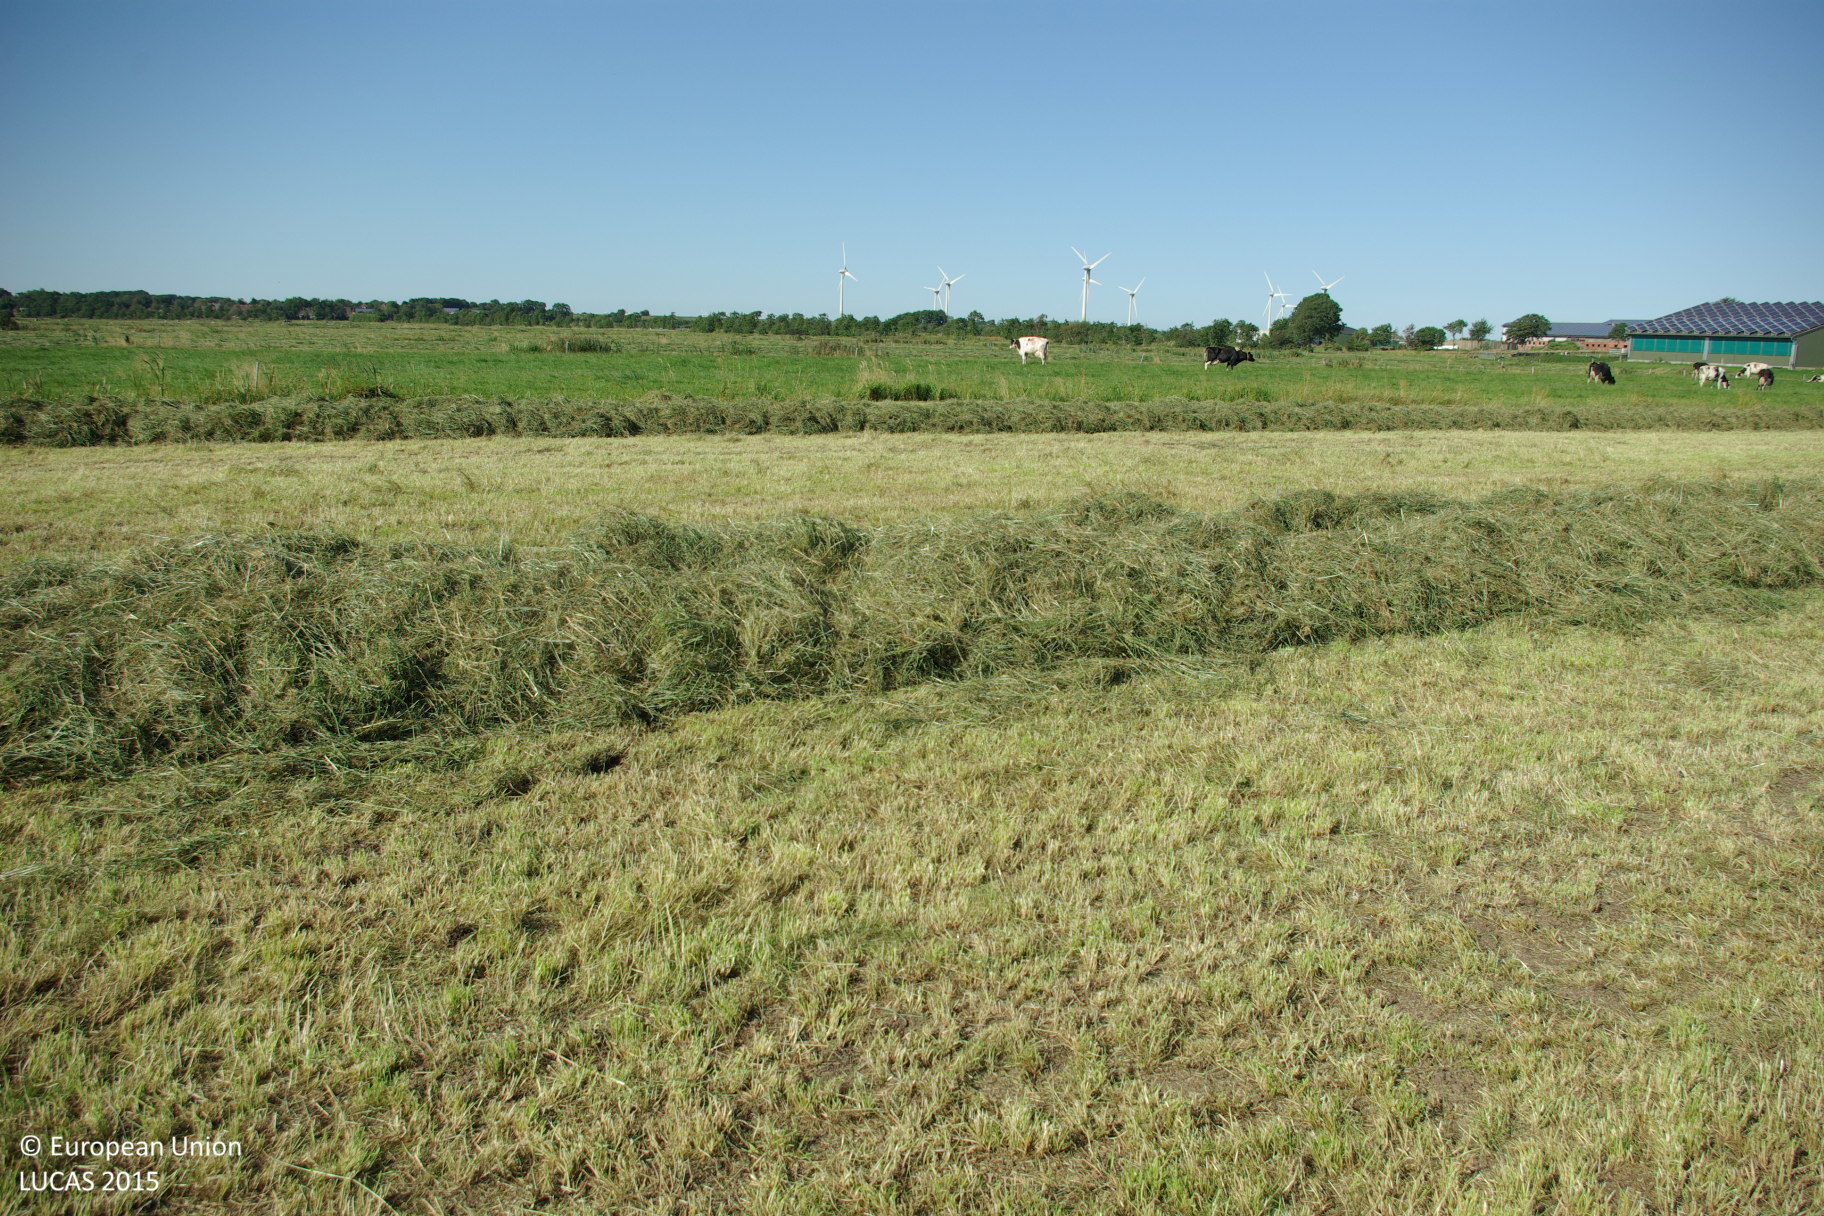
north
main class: Grassland
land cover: Grassland without tree/shrub cover
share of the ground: > 75 %
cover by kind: herbaceous plants 100 %
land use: Agriculture (excluding fallow land and kitchen gardens)
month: August
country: DE
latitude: 54.5665
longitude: 9.0572
